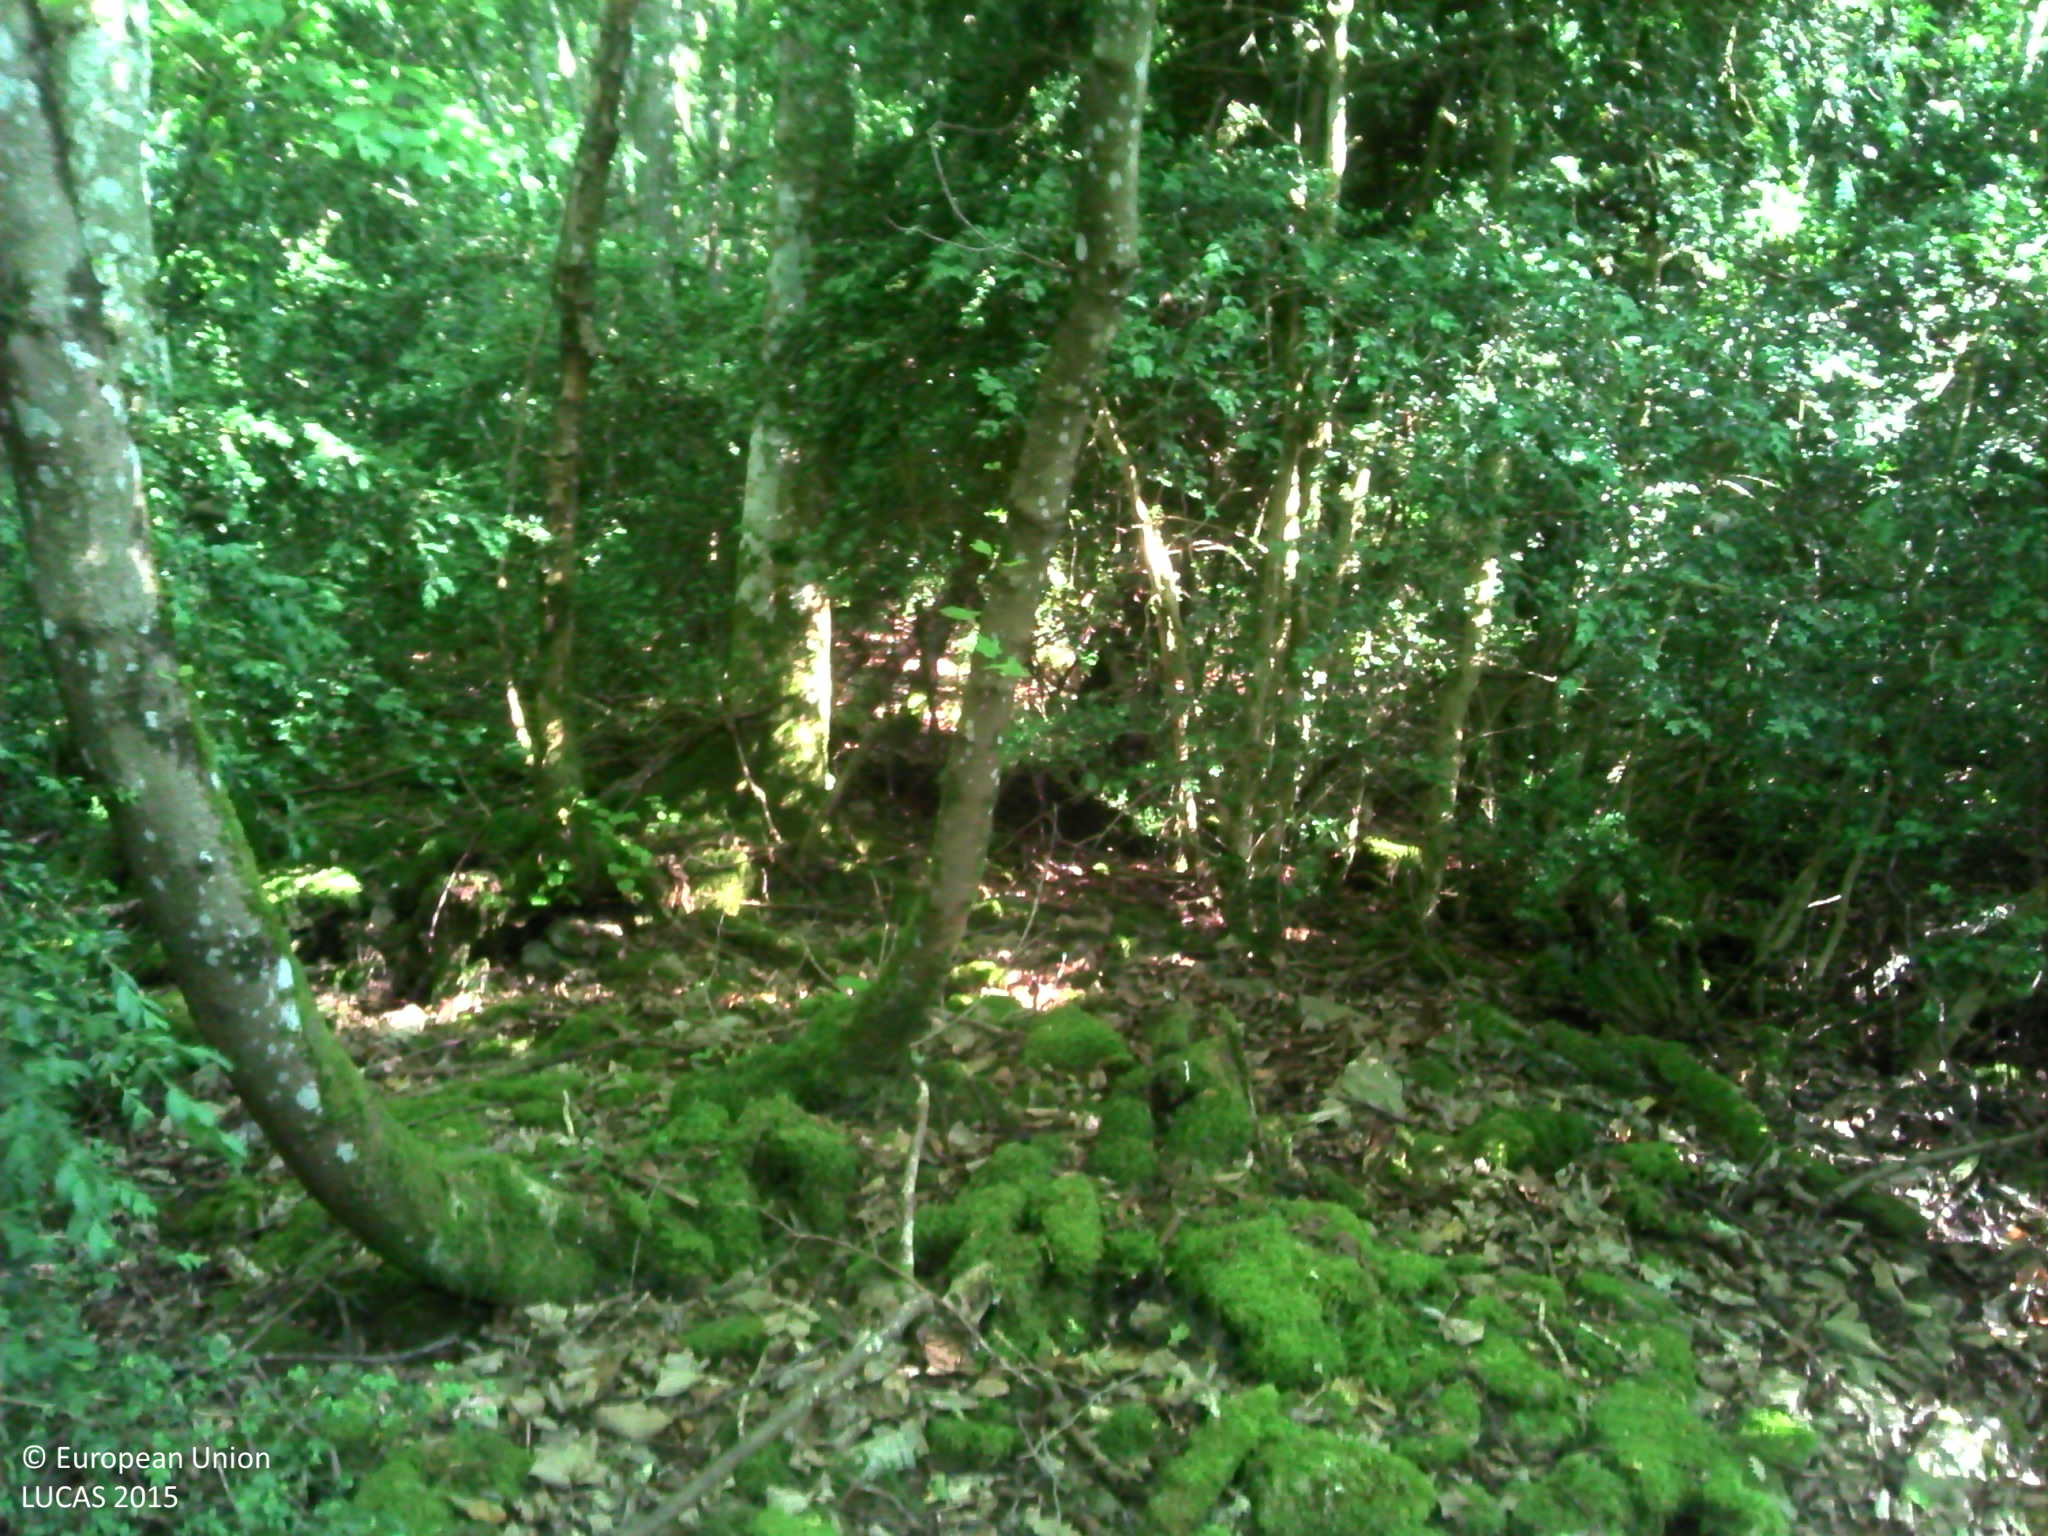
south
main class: Woodland
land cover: Broadleaved woodland
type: acidophilous oak and oak-birch forest
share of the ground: > 75 %
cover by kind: broadleaved forest trees 80 %, herbaceous plants 10 %, lichens and mosses 10 %
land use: Forestry
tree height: > 5 m
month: June
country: FR
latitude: 46.6046
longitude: 4.8187
